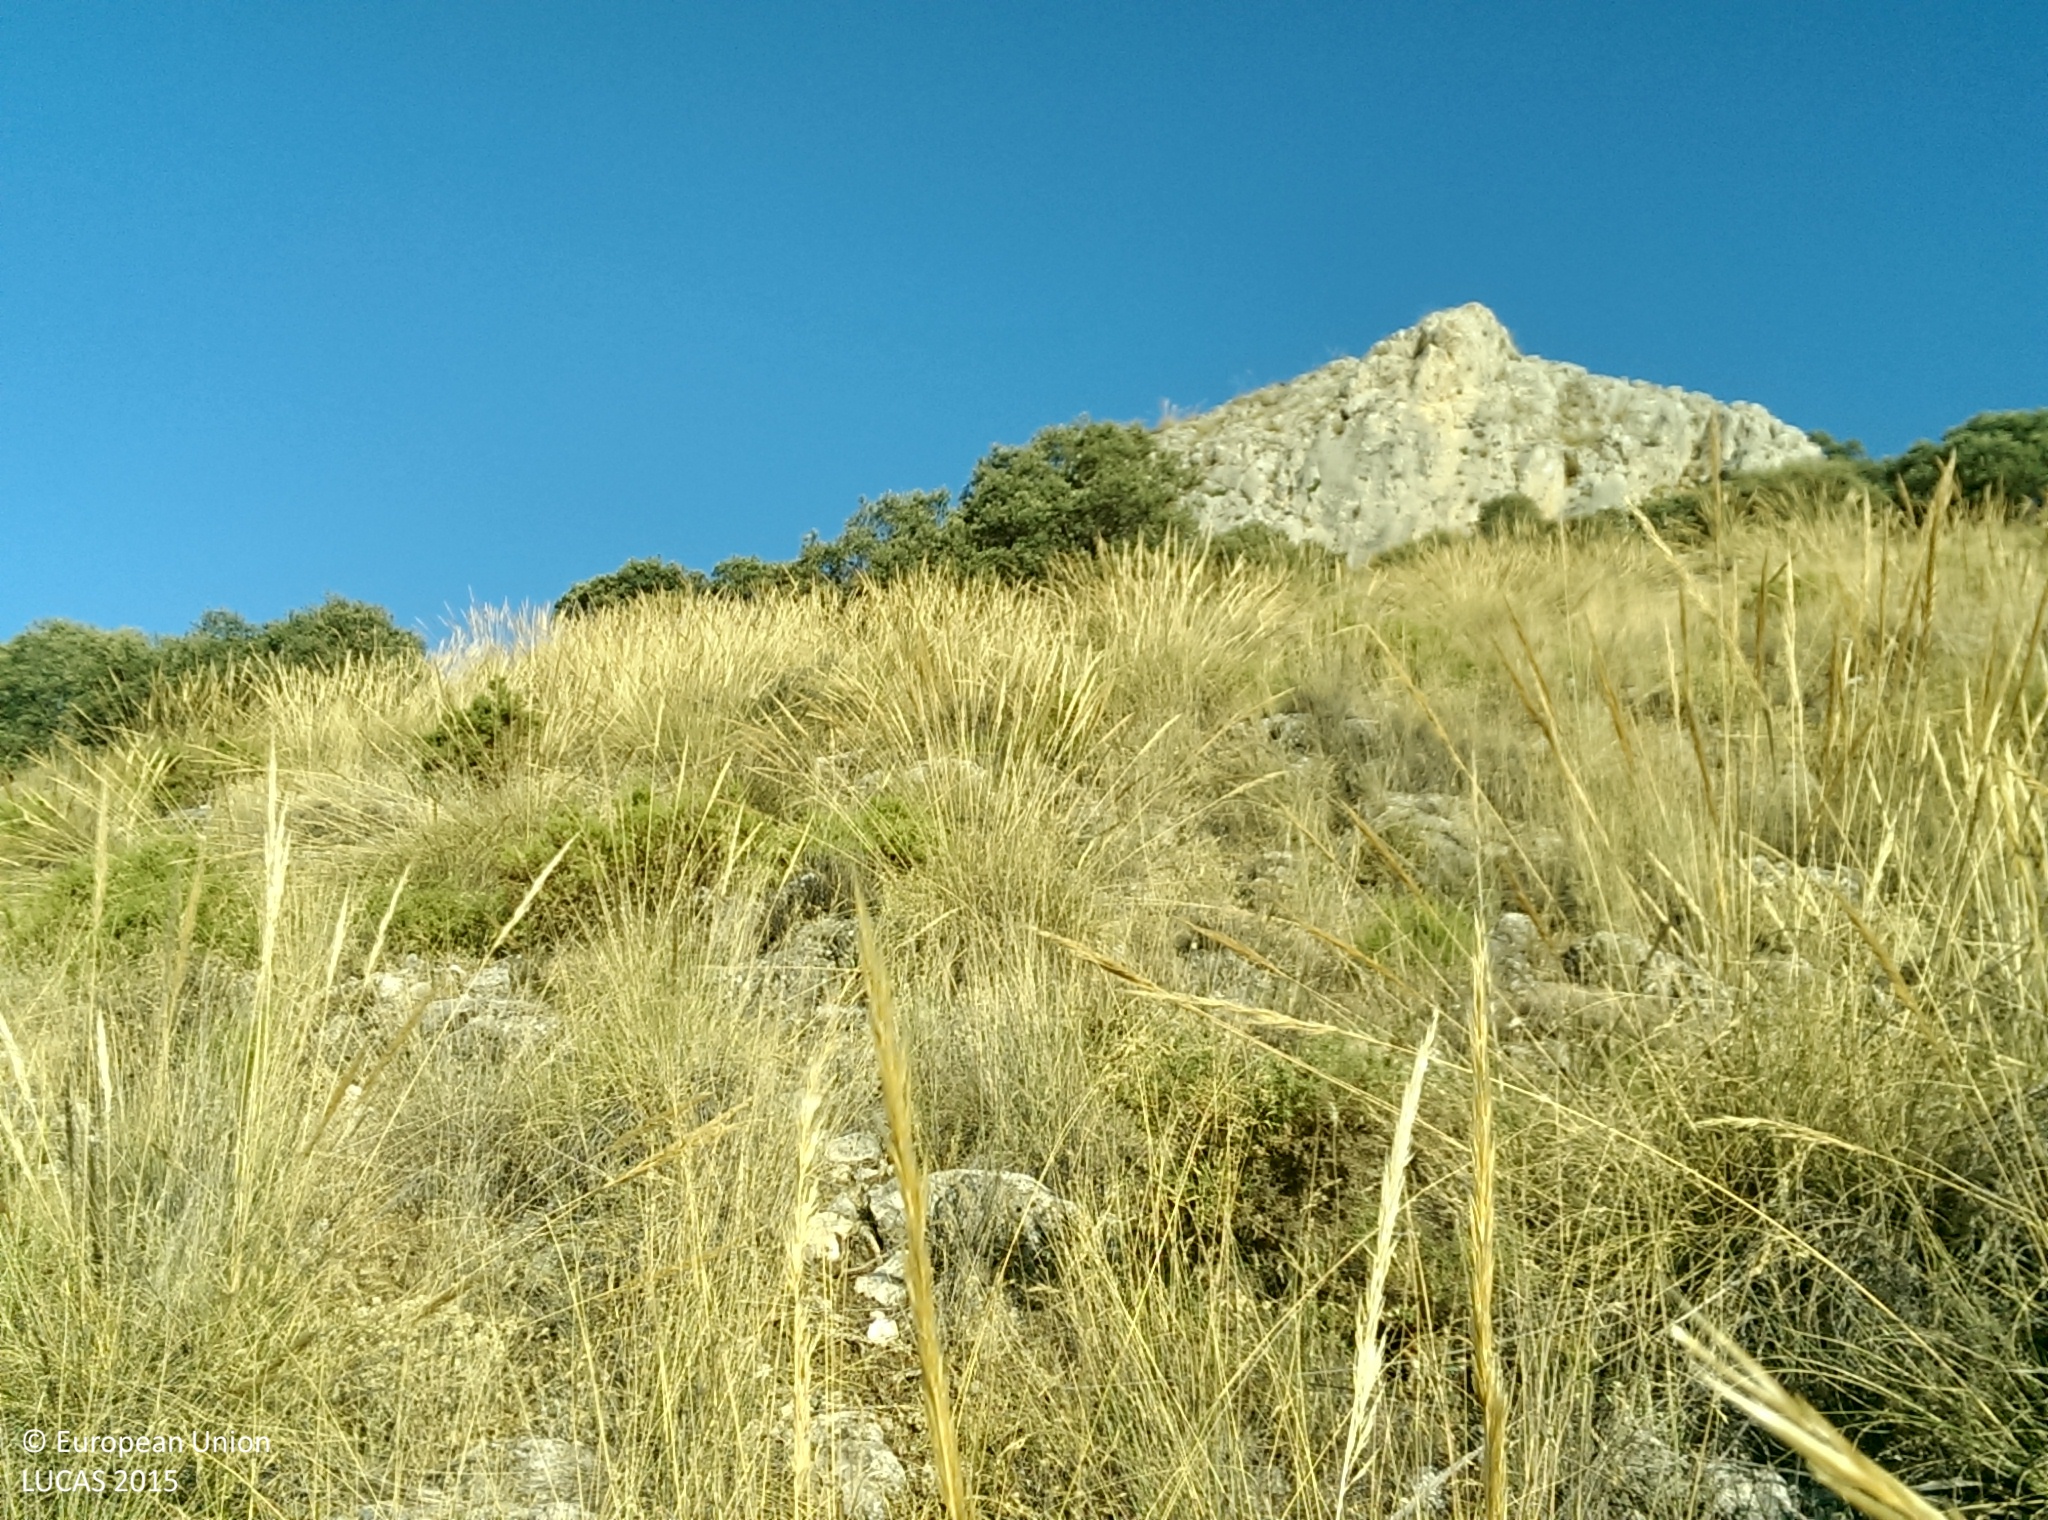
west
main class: Shrubland
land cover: Shrubland without tree cover
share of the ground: 10 - 25 %
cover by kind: herbaceous plants 85 %, shrubs 10 %, consolidated bare surface 5 %
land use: Semi-natural and natural areas not in use
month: July
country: ES
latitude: 37.3879
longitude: -3.7396
